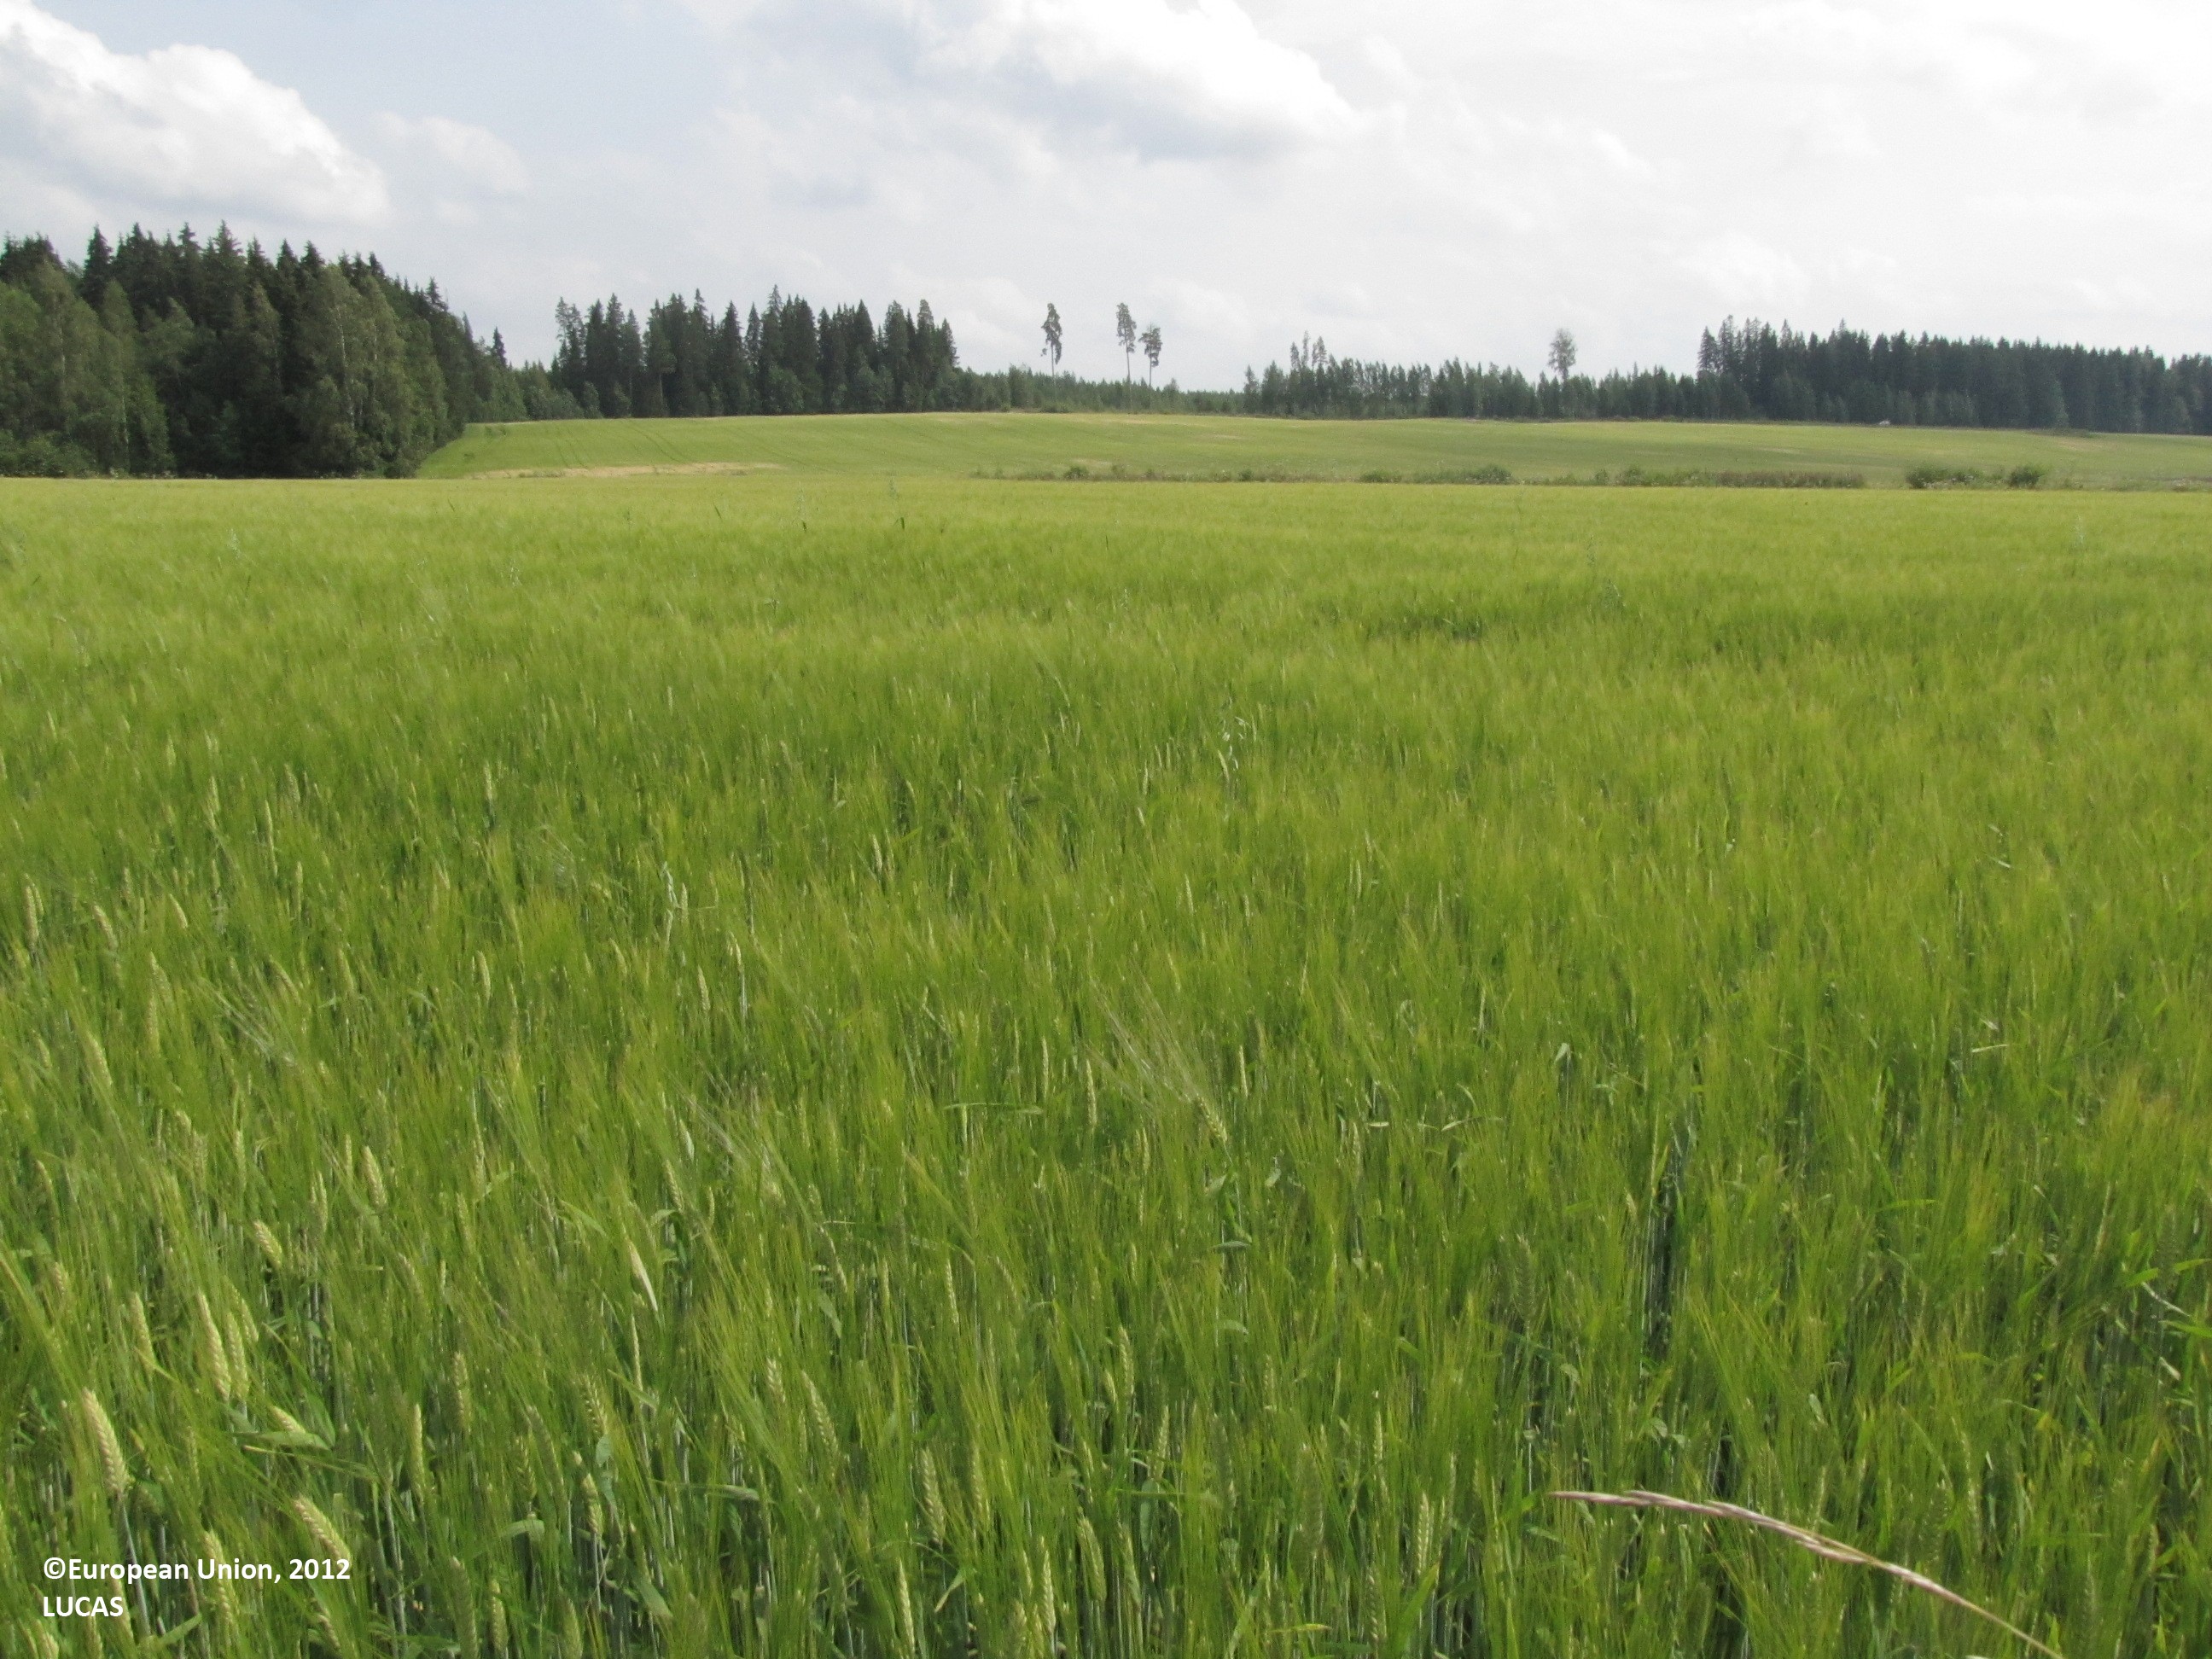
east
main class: Cropland
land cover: Temporary grasslands
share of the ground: > 75 %
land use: Agriculture (excluding fallow land and kitchen gardens)
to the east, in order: Temporary grasslands; Grassland without tree/shrub cover; Abandoned hedges; Inland running water; Shrubland without tree cover; Electric lines; Barley; Grass margins; Ditches and canals
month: July
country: FI
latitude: 62.0061
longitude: 23.0349
